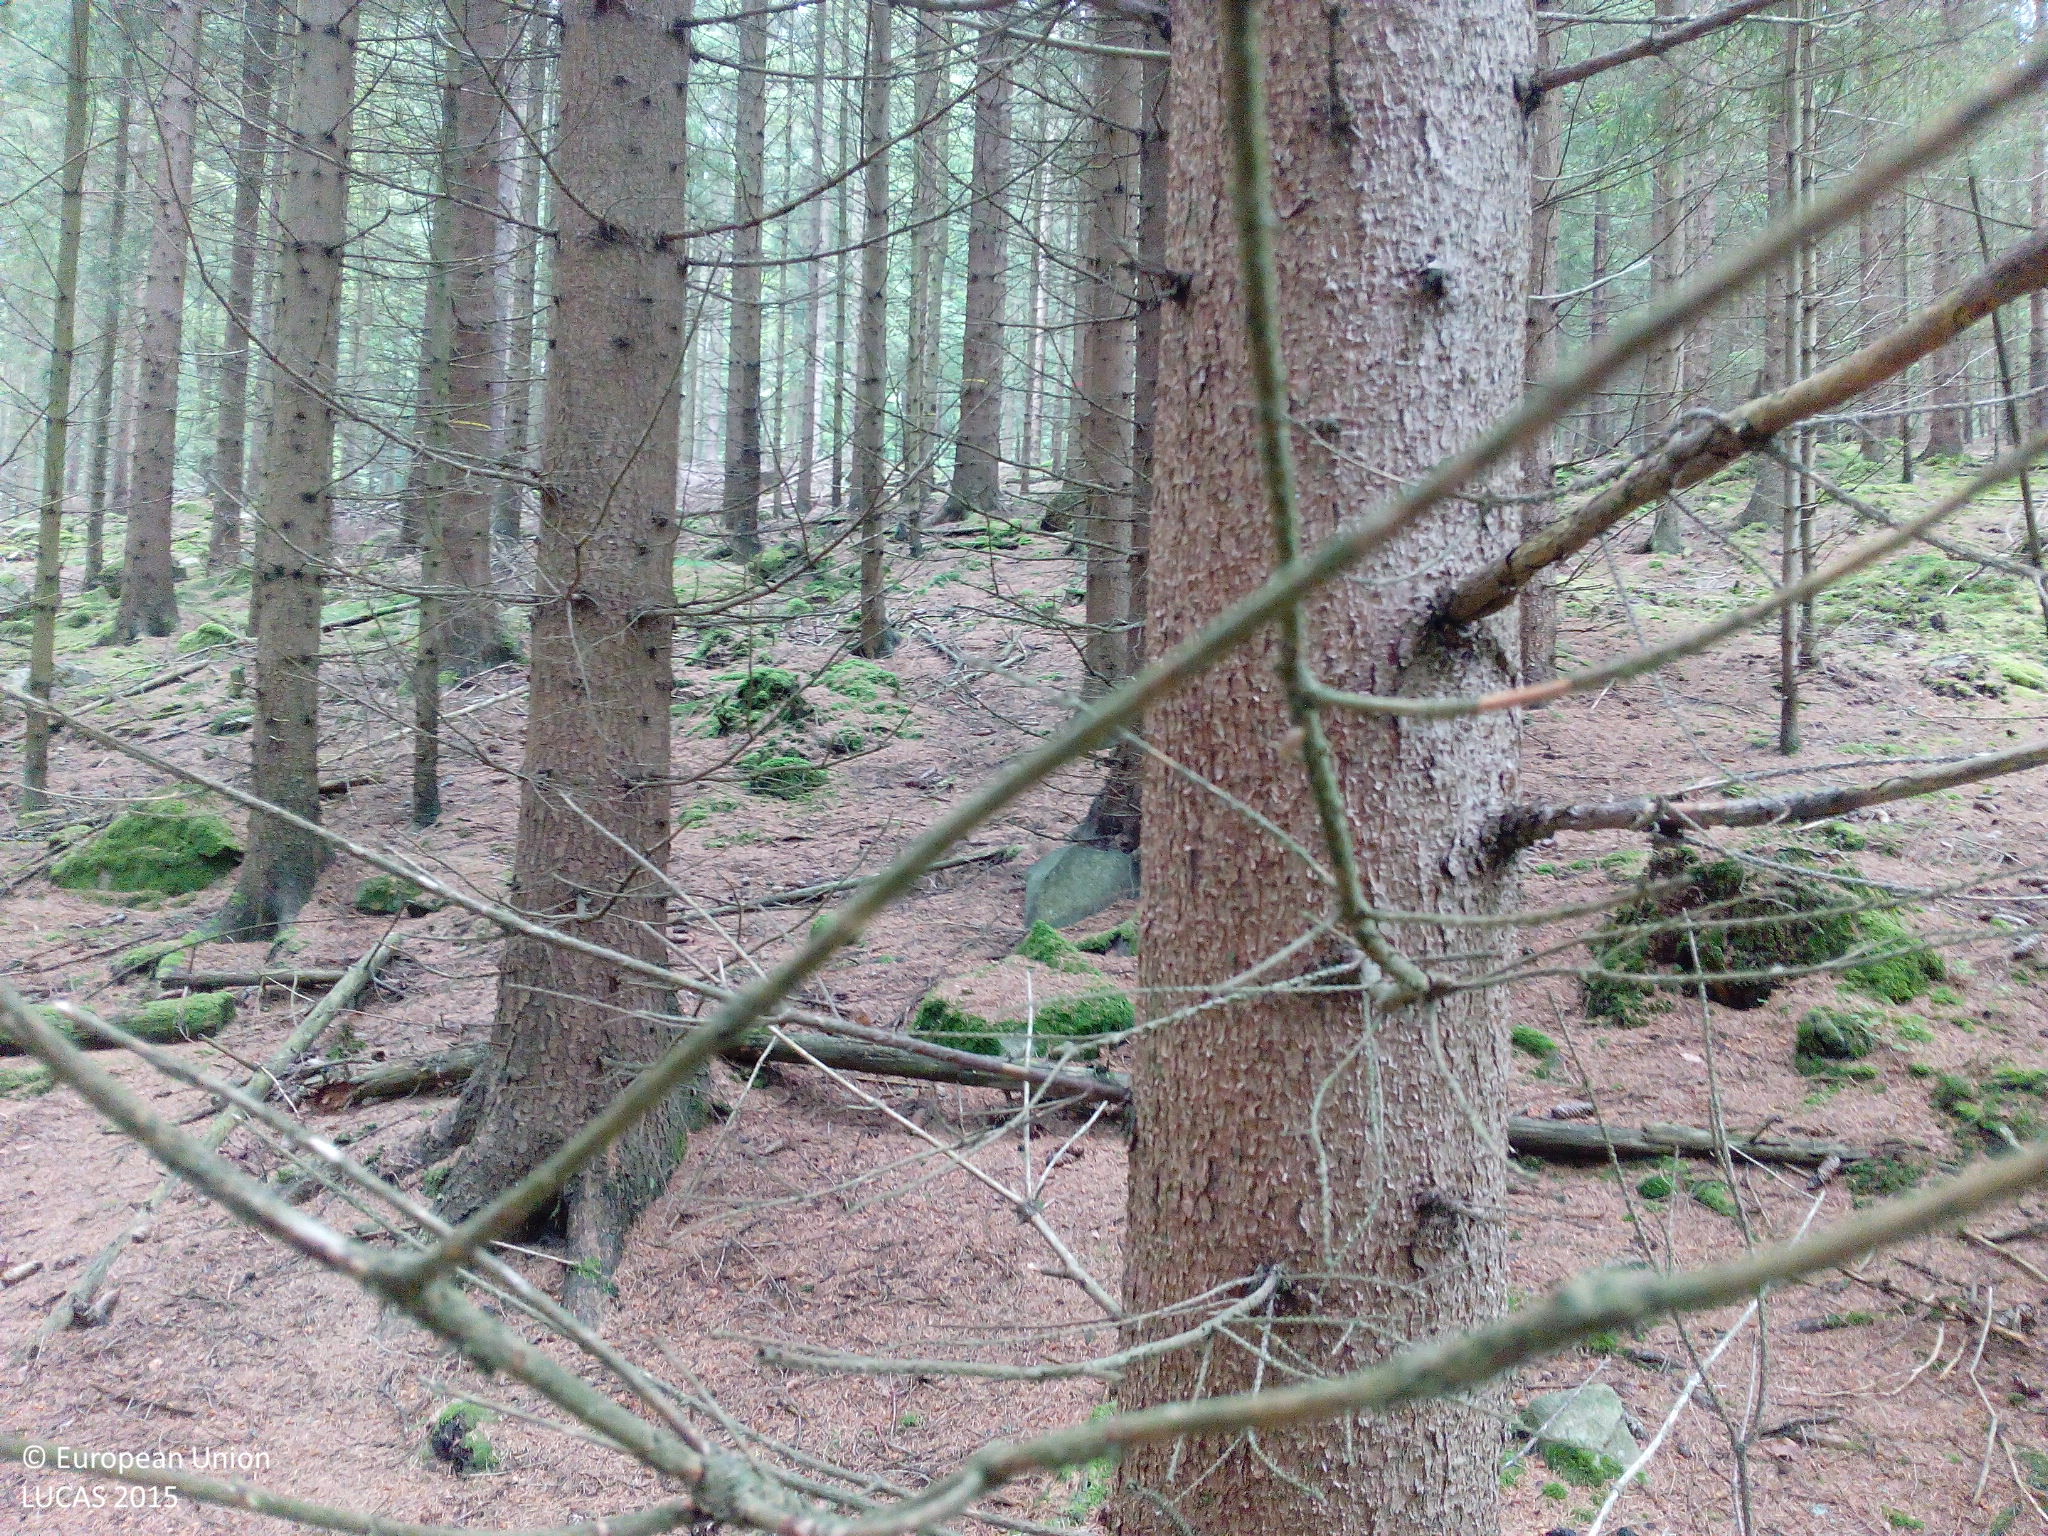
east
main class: Woodland
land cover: Spruce dominated coniferous woodland
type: hemiboreal forest and nemoral coniferous forest and mixed broadleaved-coniferous forest
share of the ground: > 75 %
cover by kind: coniferous forest trees 85 %, lichens and mosses 5 %, consolidated bare surface 5 %, unconsolidated bare surface 5 %
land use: Forestry
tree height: > 5 m
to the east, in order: Spruce dominated coniferous woodland; Spruce dominated mixed woodland; Tracks; Other mixed woodland
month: June
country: DE
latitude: 49.3851
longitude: 12.4103
